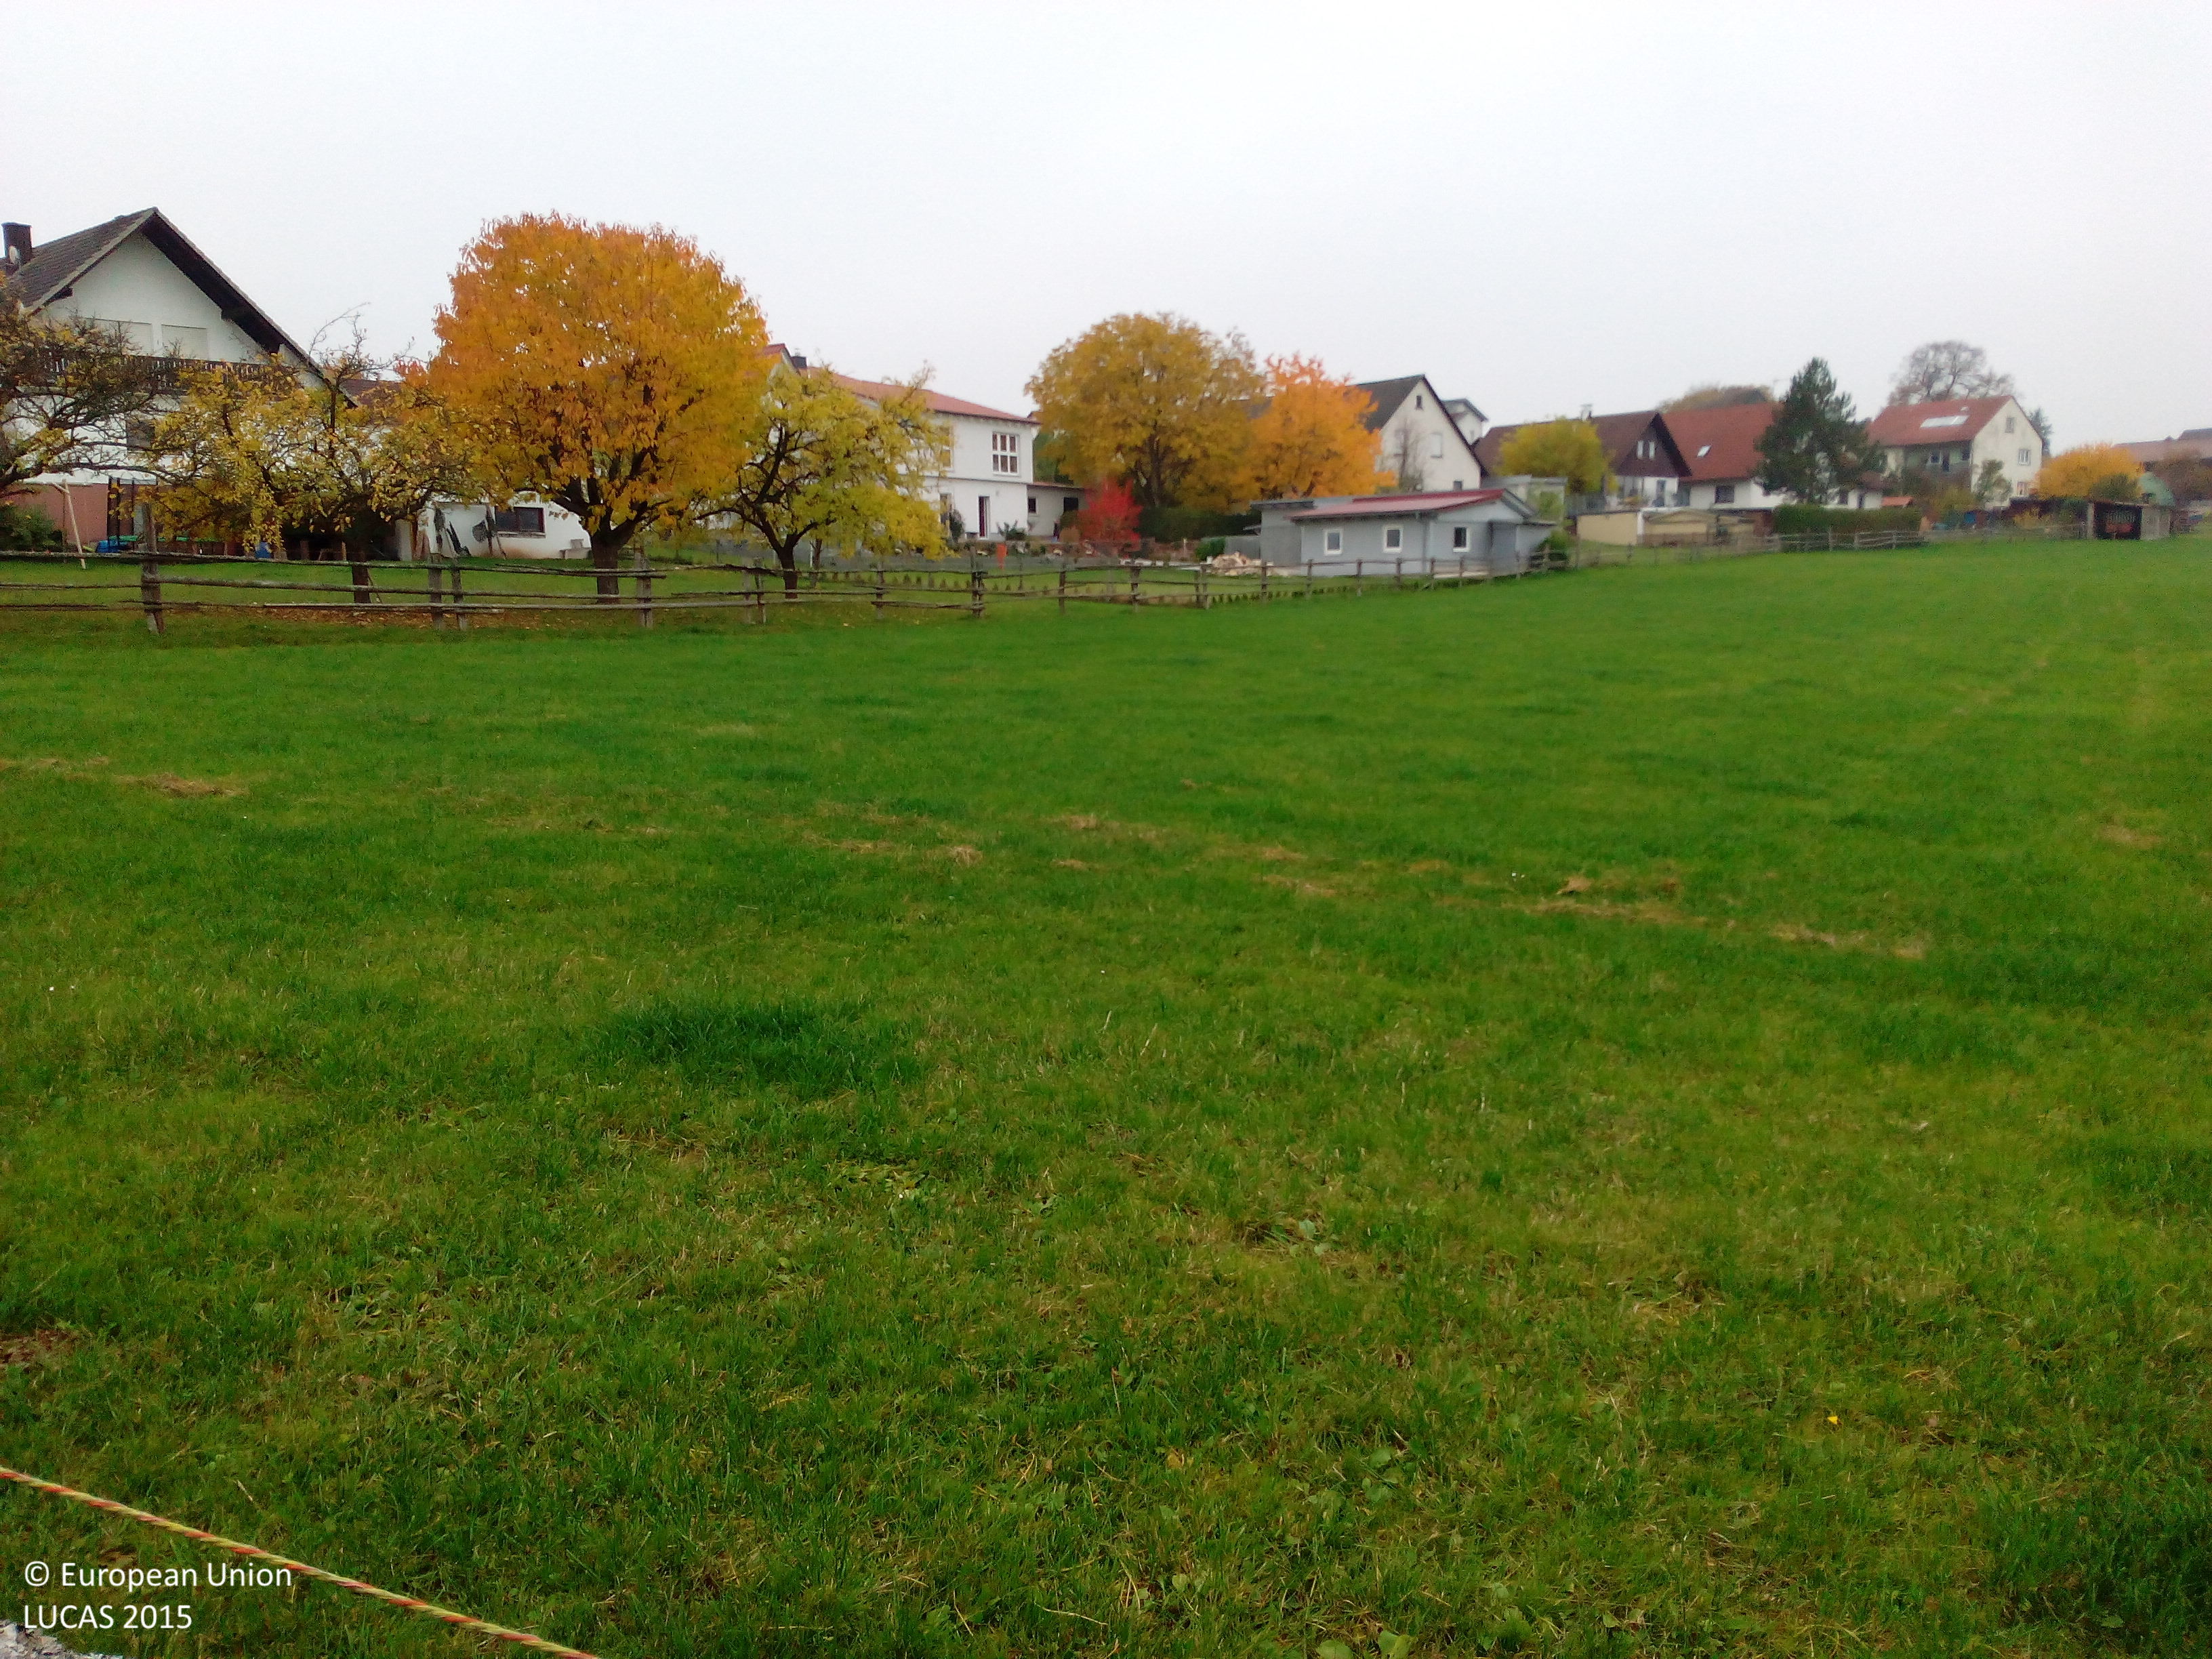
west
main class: Grassland
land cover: Grassland without tree/shrub cover
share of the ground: > 75 %
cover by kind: herbaceous plants 100 %
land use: Agriculture (excluding fallow land and kitchen gardens)
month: October
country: DE
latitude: 50.1842
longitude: 9.8740
